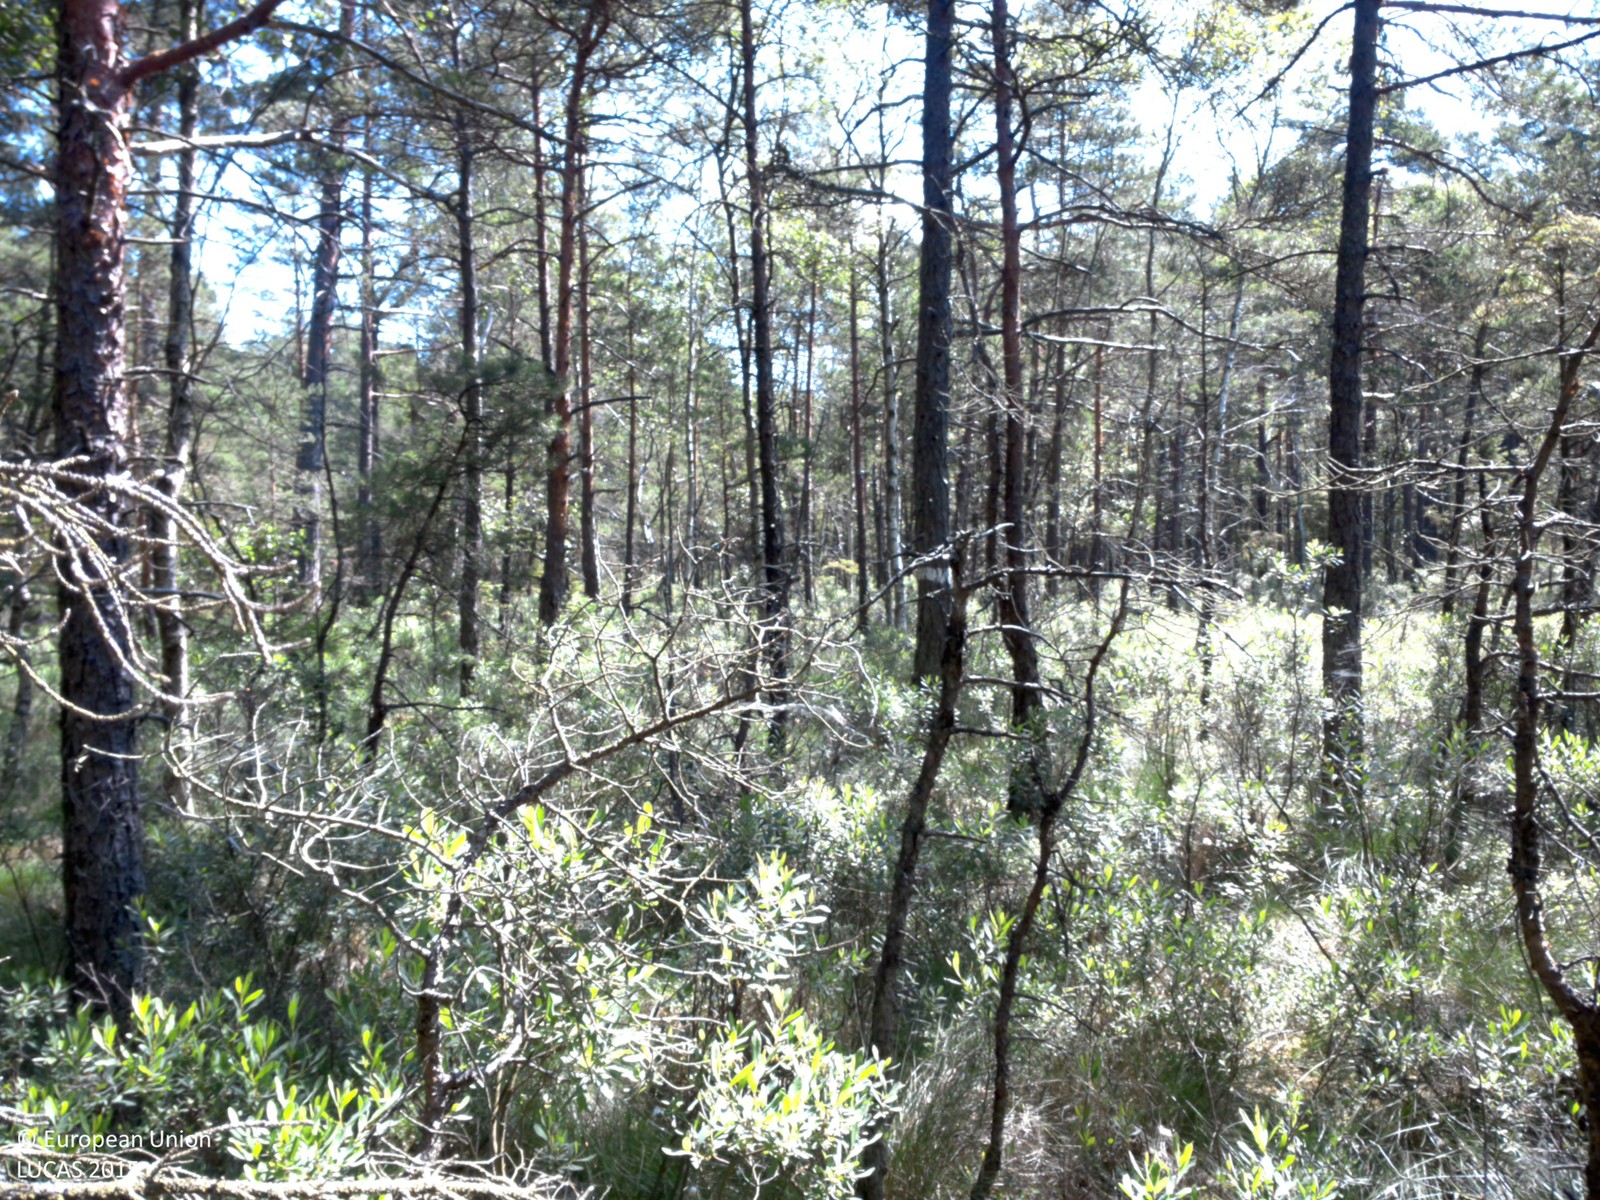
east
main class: Woodland
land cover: Pine dominated coniferous woodland
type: boreal forest
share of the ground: 25 - 50 %
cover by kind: coniferous forest trees 40 %, shrubs 25 %, herbaceous plants 25 %, lichens and mosses 10 %
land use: Forestry
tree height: < 5 m
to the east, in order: Pine dominated coniferous woodland; Other mixed woodland; Pine dominated mixed woodland; Spruce dominated mixed woodland; Spruce dominated coniferous woodland
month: July
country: SE
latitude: 57.9303
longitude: 12.2757
